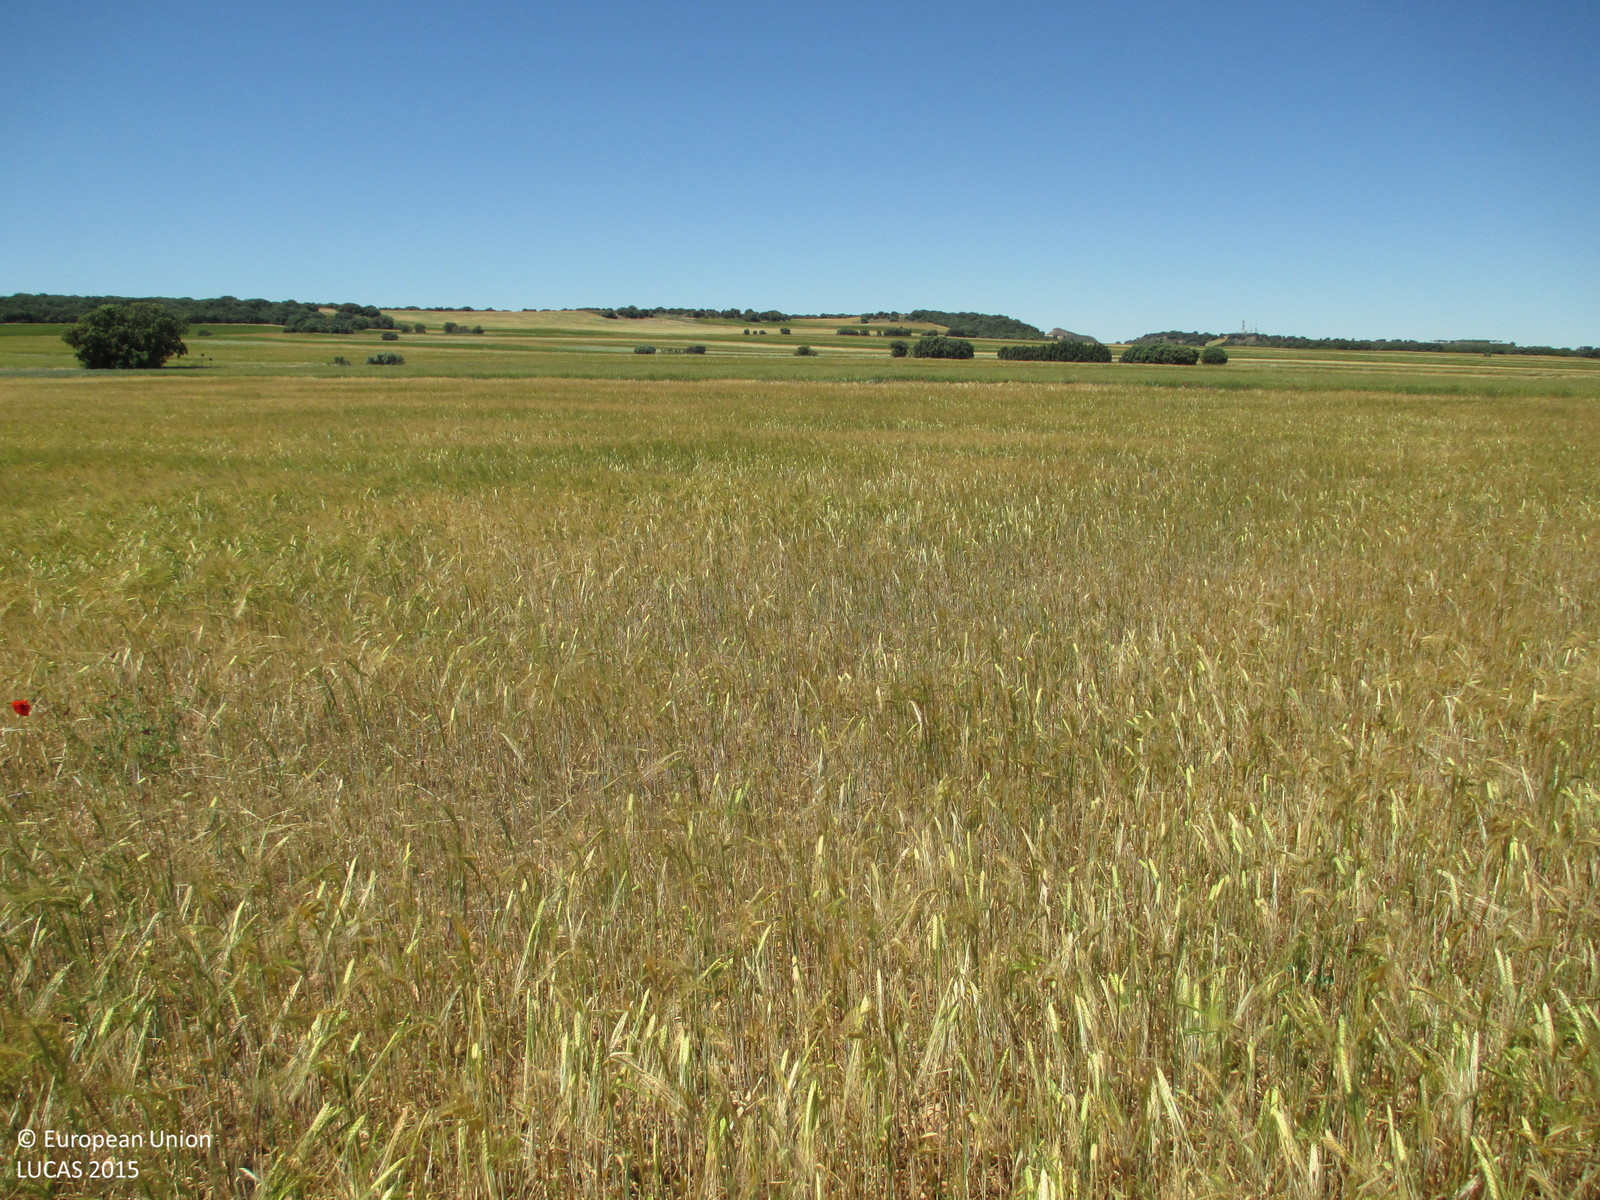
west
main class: Cropland
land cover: Barley
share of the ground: > 75 %
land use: Agriculture (excluding fallow land and kitchen gardens)
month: May
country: ES
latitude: 42.0032
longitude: -0.2708
